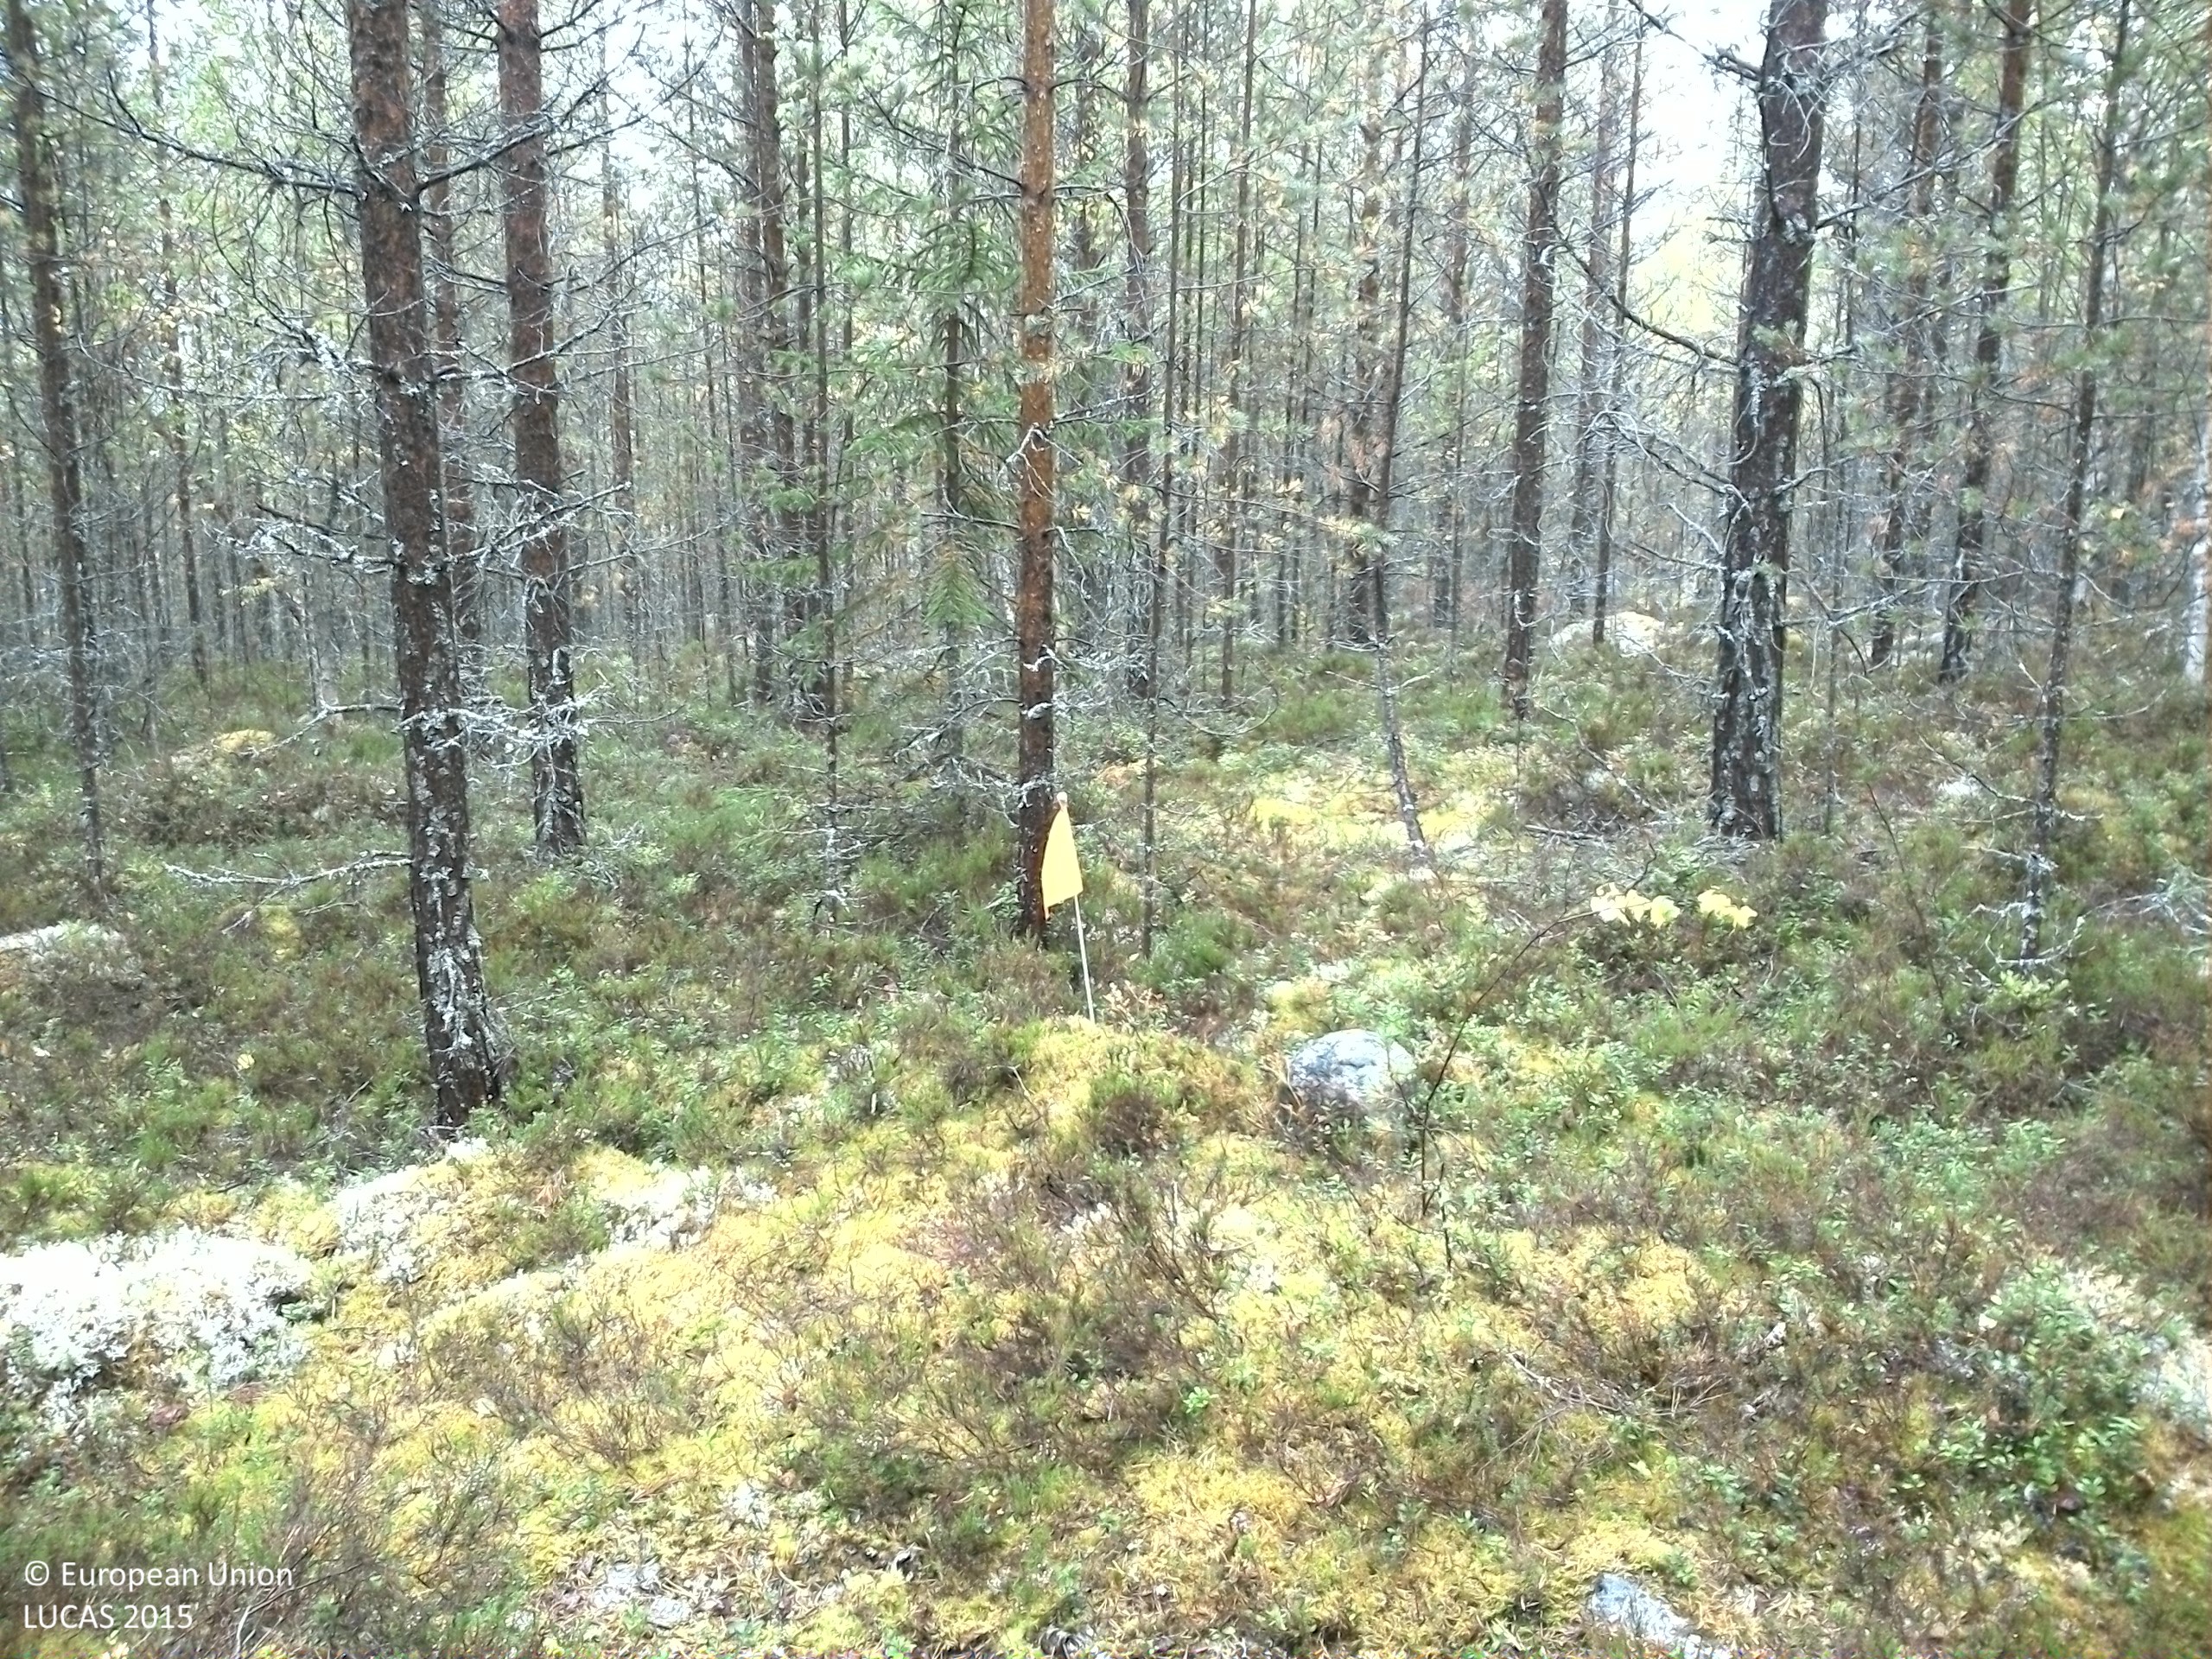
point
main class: Woodland
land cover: Pine dominated coniferous woodland
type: boreal forest
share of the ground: > 75 %
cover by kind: coniferous forest trees 75 %, shrubs 10 %, lichens and mosses 10 %, broadleaved forest trees 5 %
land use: Forestry
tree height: > 5 m
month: September
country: SE
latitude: 61.5126
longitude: 15.1526
